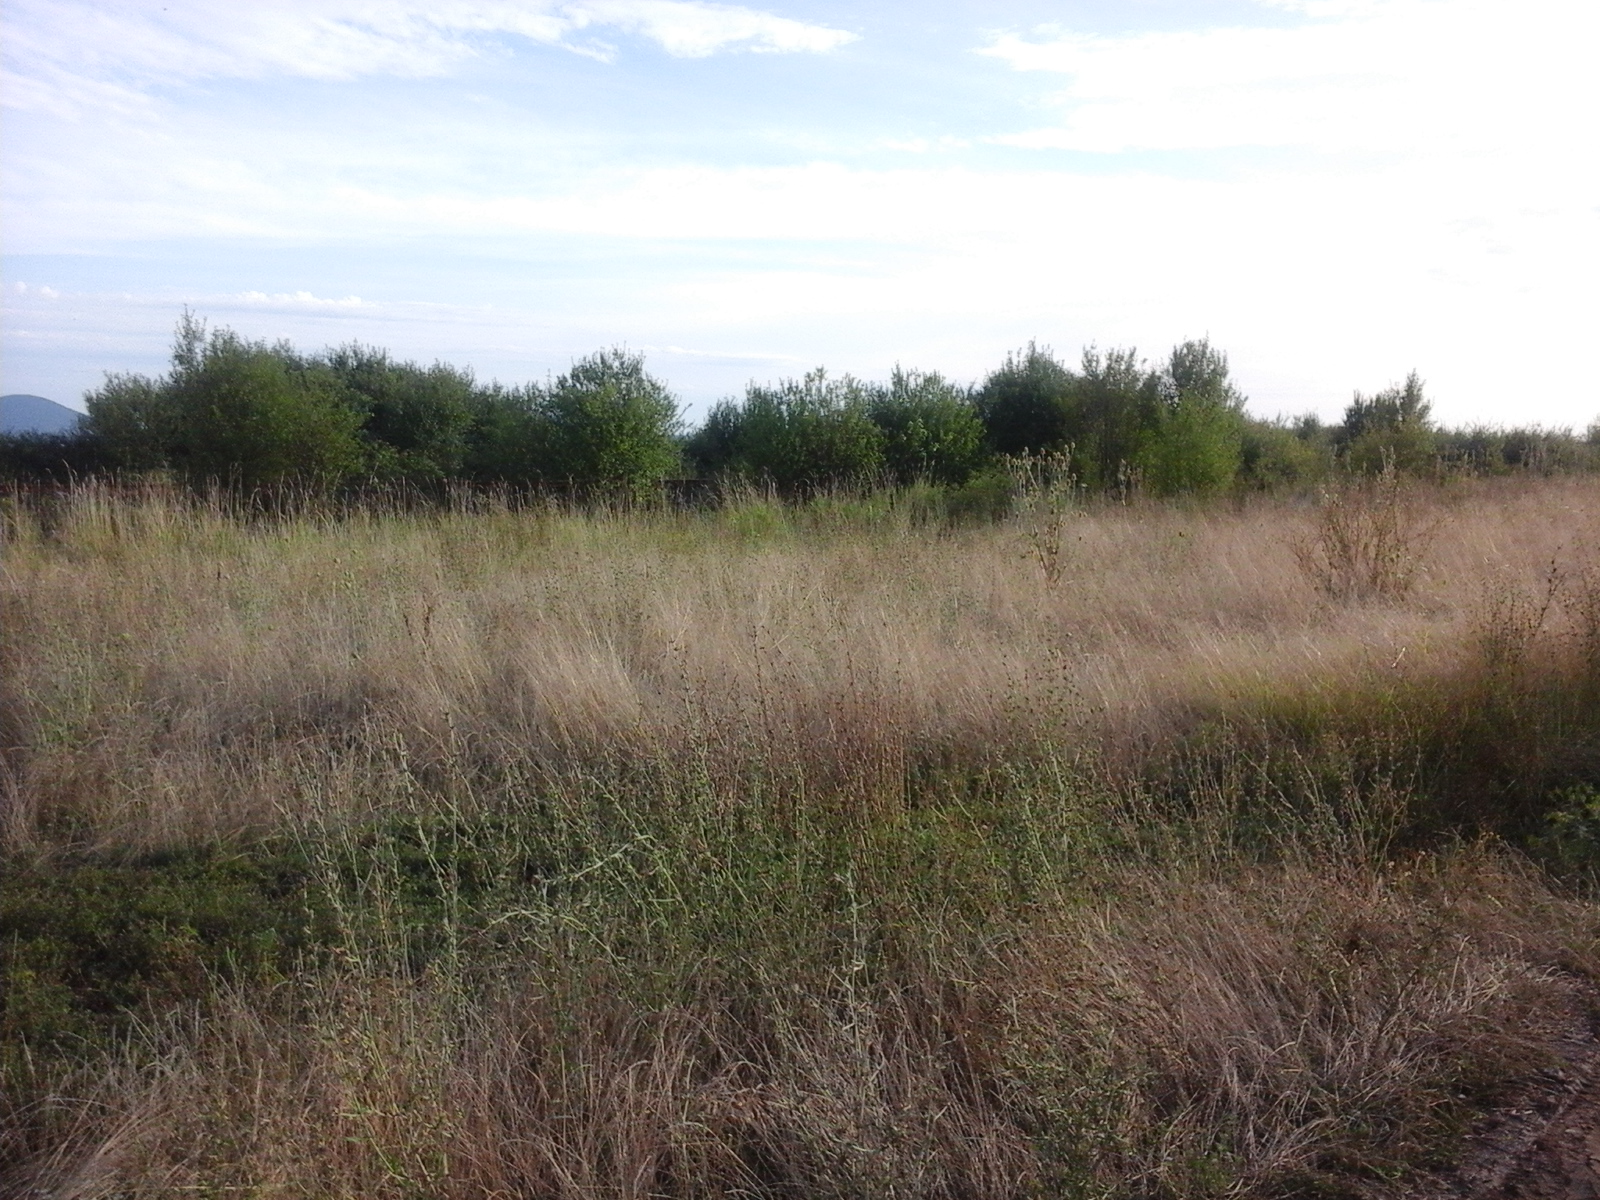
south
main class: Grassland
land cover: Grassland without tree/shrub cover
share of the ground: > 75 %
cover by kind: herbaceous plants 100 %
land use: Agriculture (excluding fallow land and kitchen gardens)
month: August
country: RO
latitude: 45.2655
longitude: 21.4110
